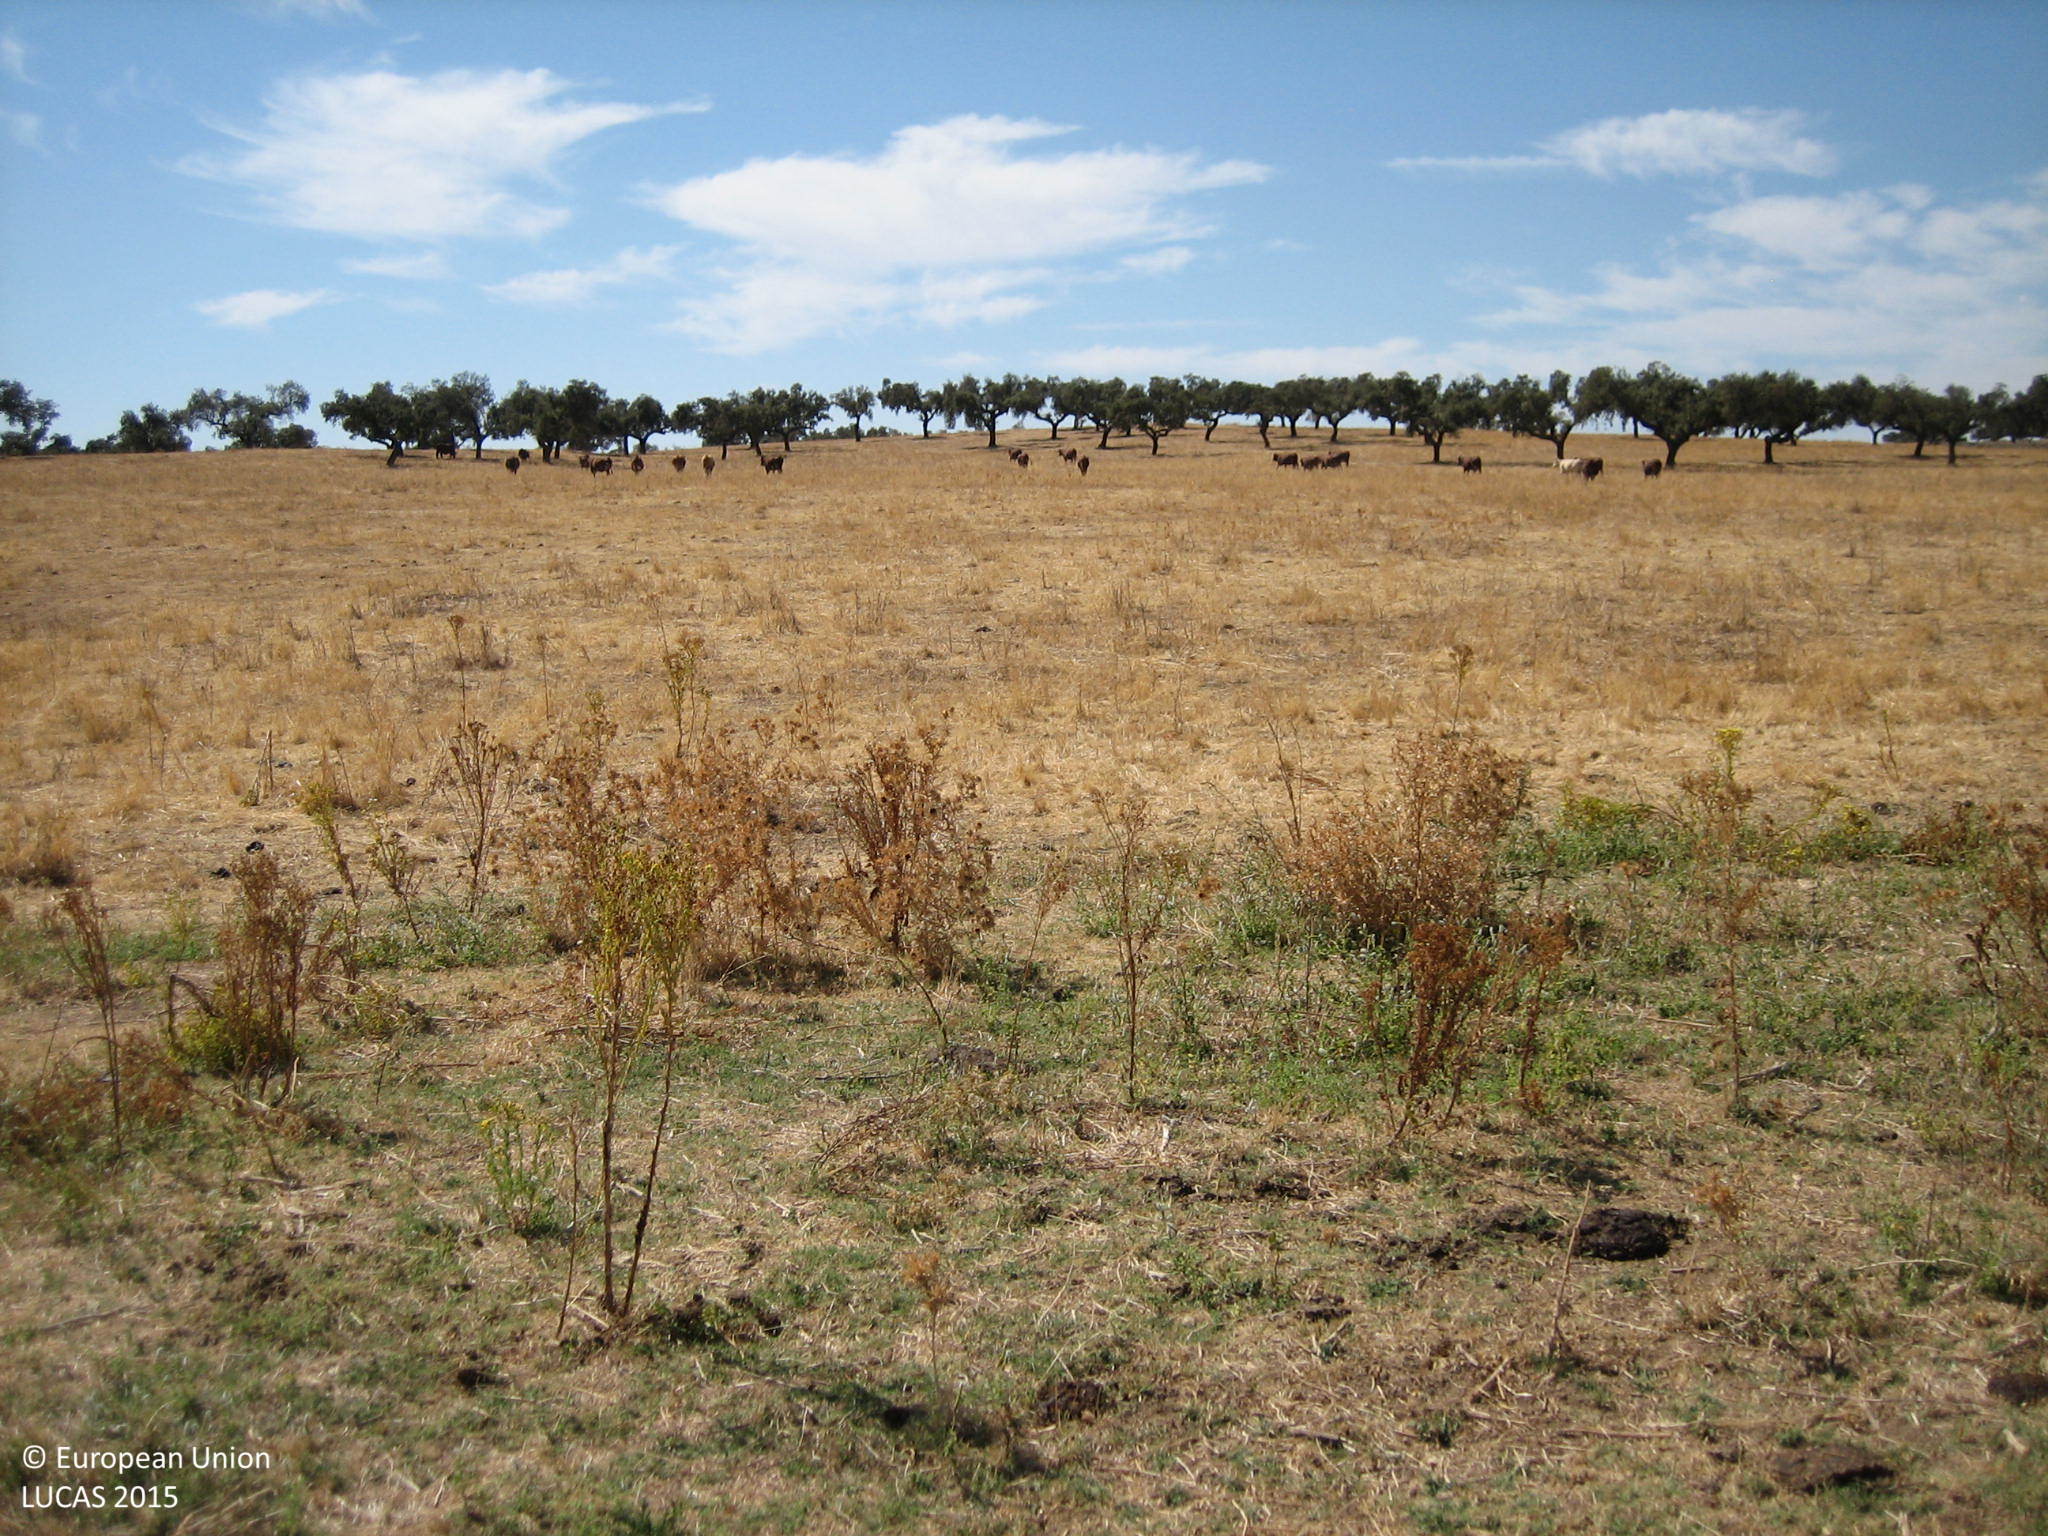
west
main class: Grassland
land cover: Grassland without tree/shrub cover
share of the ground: 50 - 75 %
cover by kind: herbaceous plants 70 %, unconsolidated bare surface 30 %
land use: Agriculture (excluding fallow land and kitchen gardens)
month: August
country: ES
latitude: 38.3529
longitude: -7.1718
